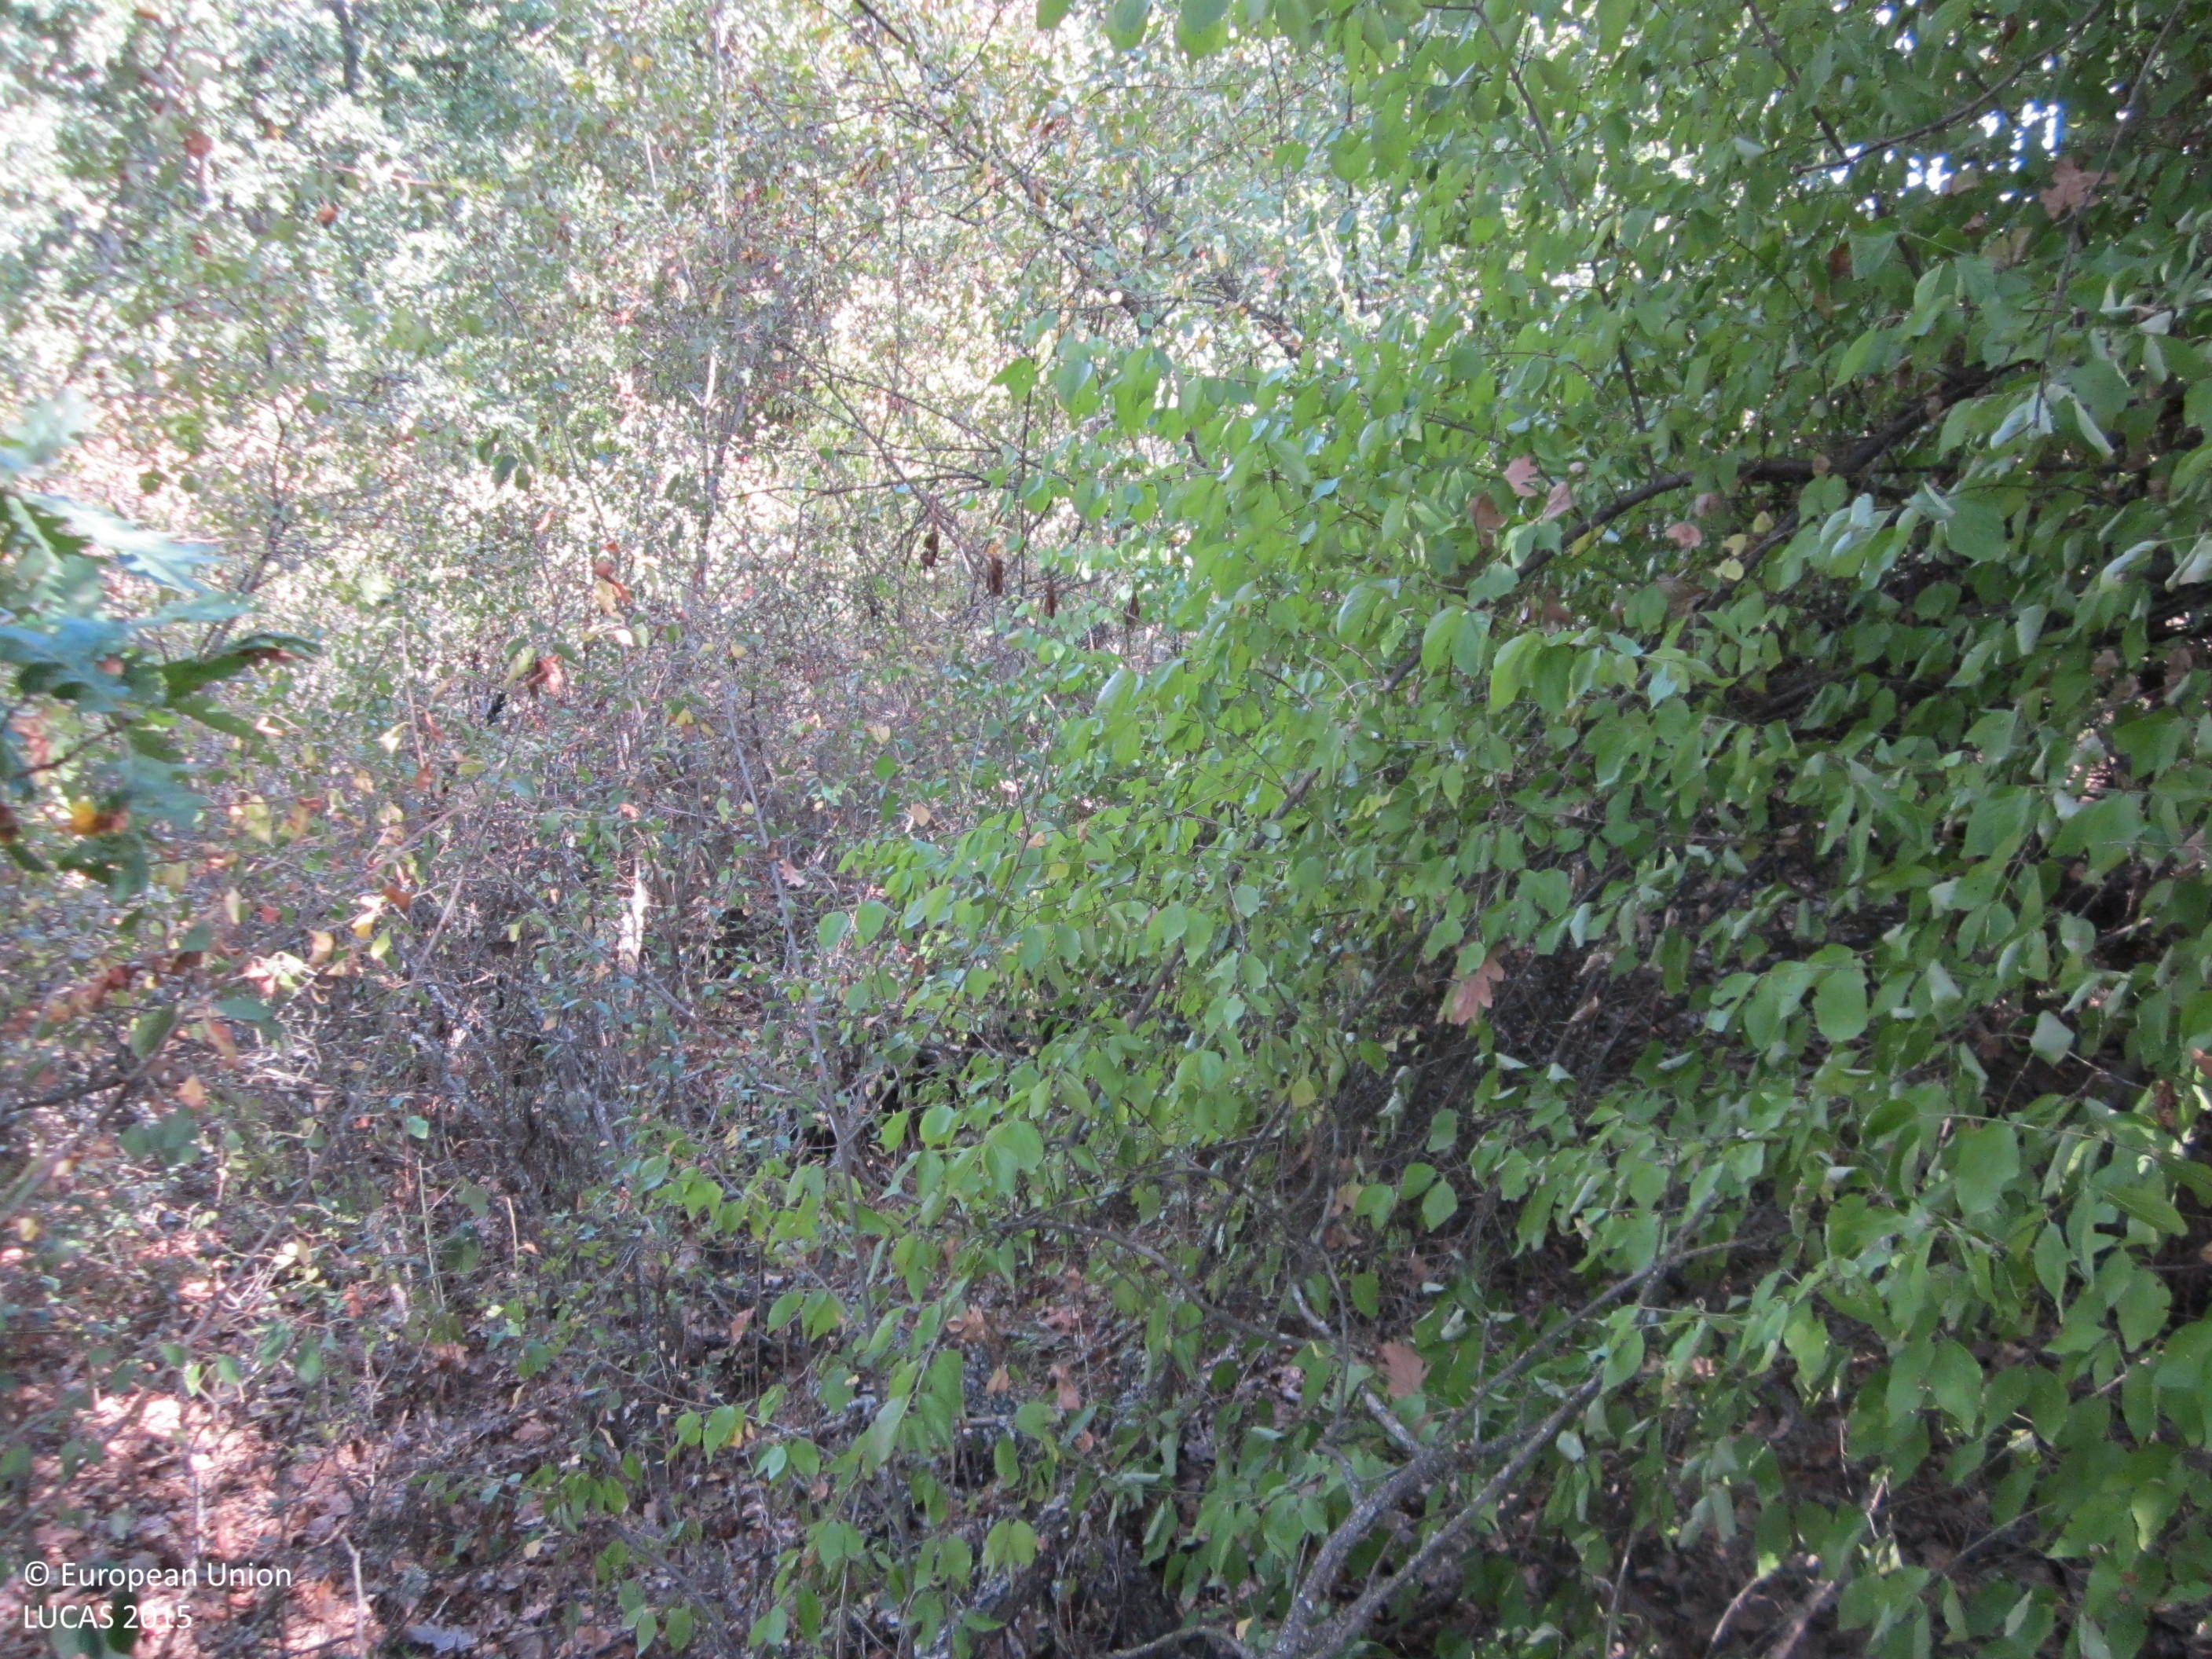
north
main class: Woodland
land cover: Broadleaved woodland
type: thermophilous deciduous forest
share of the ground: > 75 %
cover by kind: broadleaved forest trees 90 %, shrubs 5 %, herbaceous plants 5 %
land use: Forestry
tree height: > 5 m
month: September
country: BG
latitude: 42.1578
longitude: 27.1319
